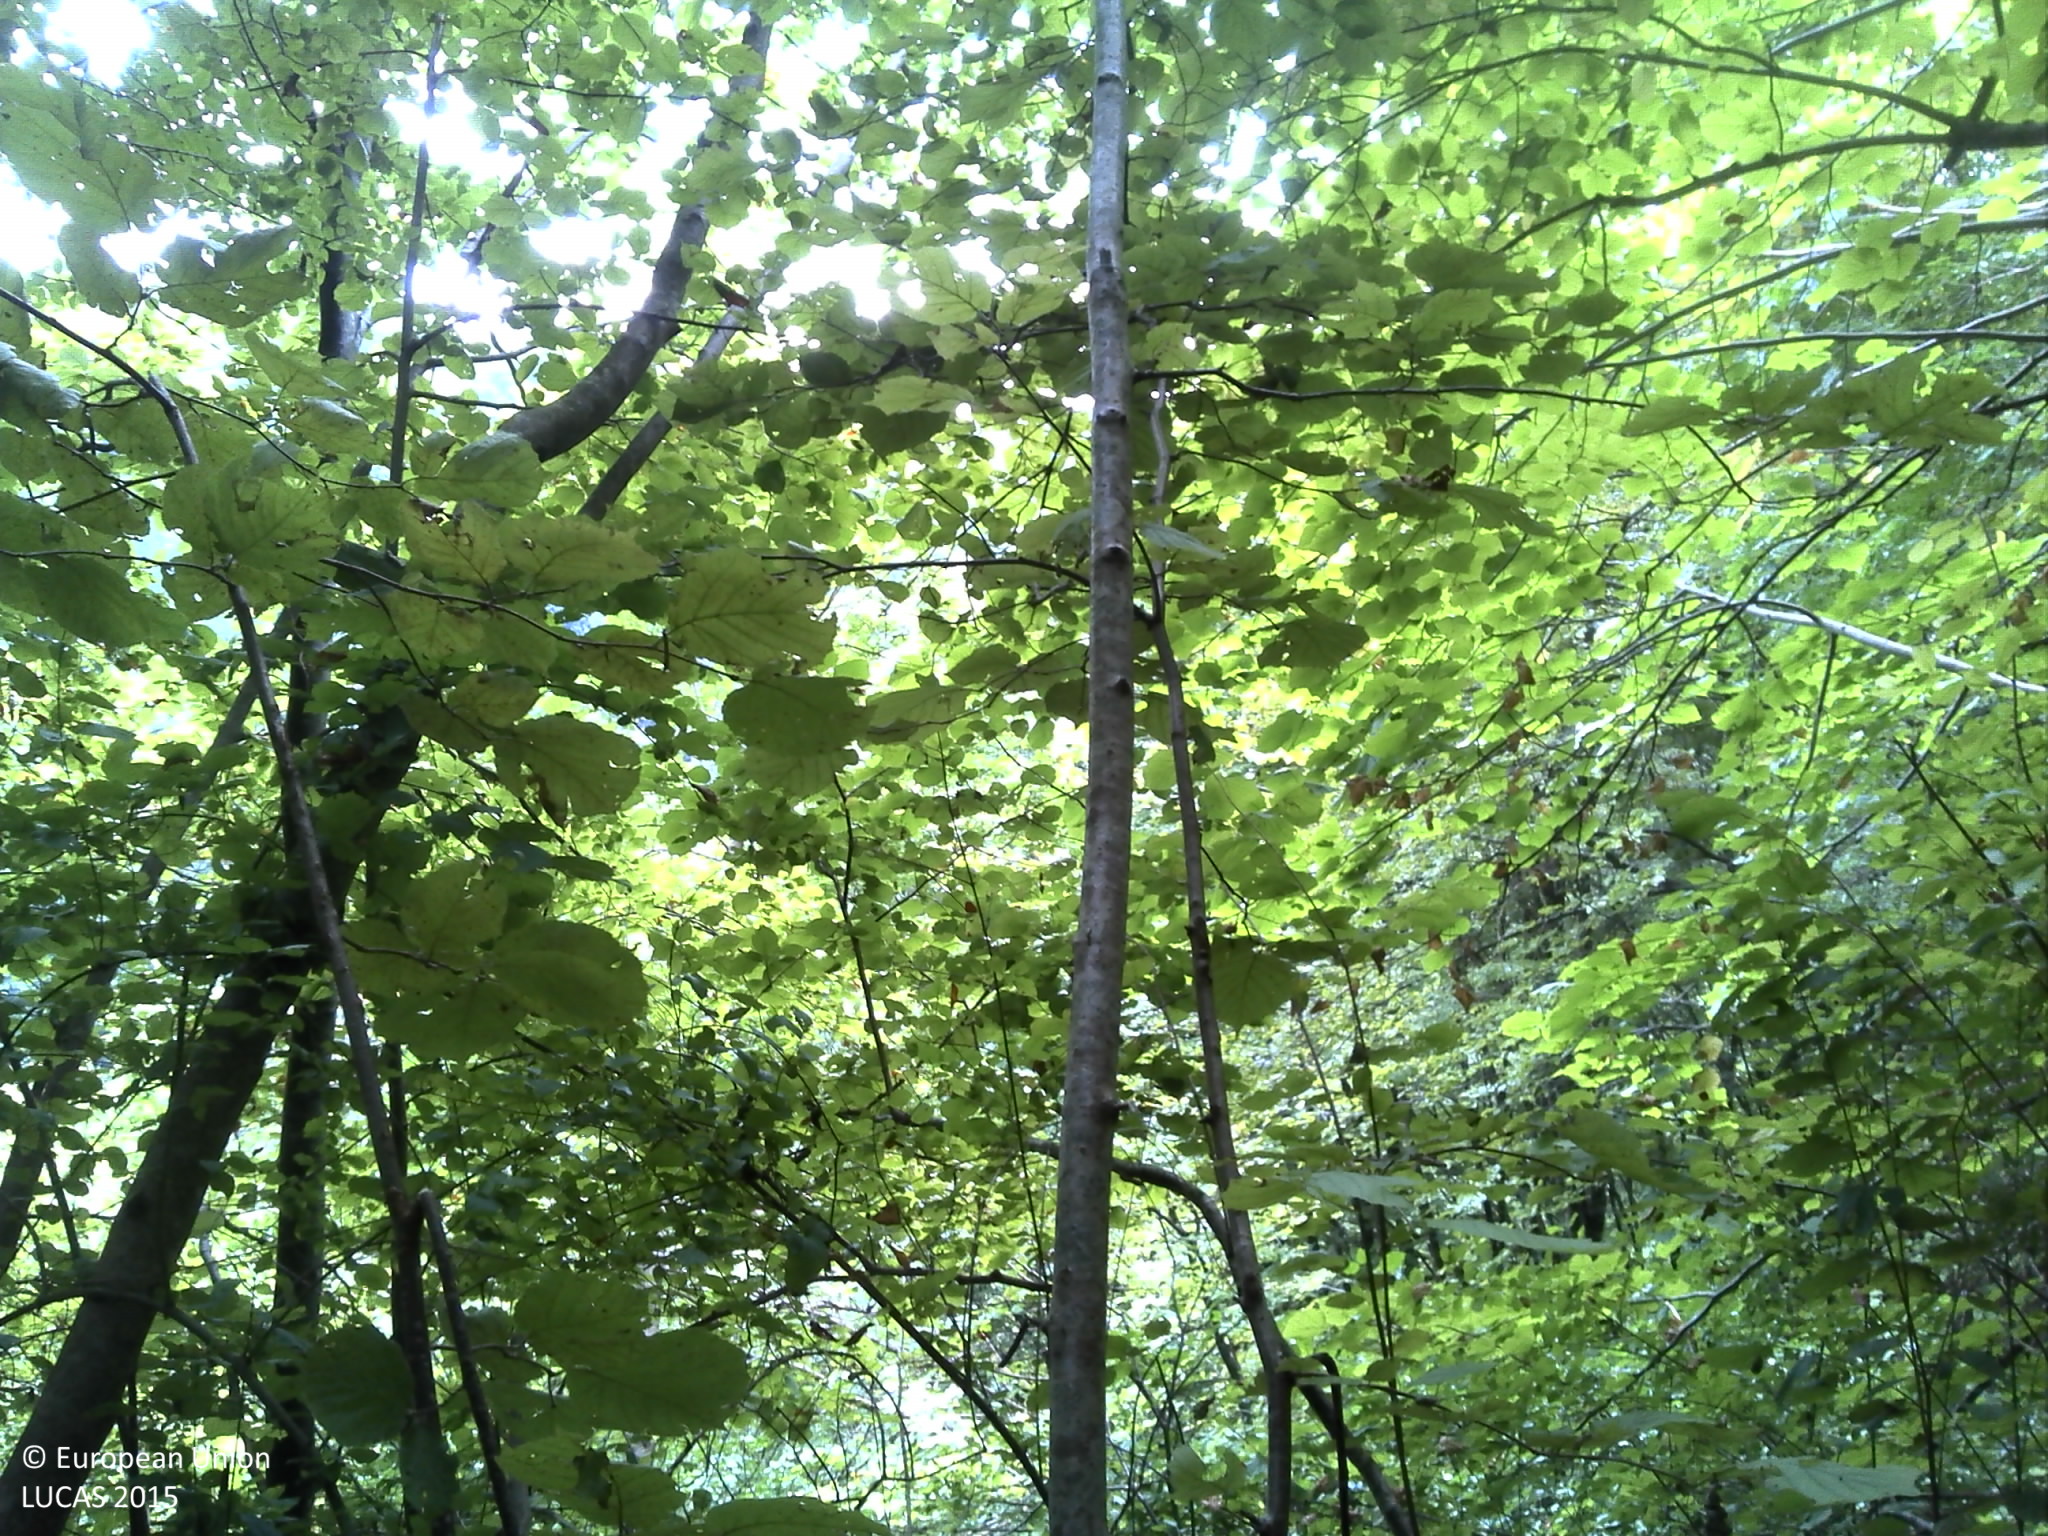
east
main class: Woodland
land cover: Broadleaved woodland
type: beech forest
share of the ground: > 75 %
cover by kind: broadleaved forest trees 100 %
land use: Forestry
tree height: > 5 m
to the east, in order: Broadleaved woodland; Tracks; Shrubland with sparse tree cover; Broadleaved woodland; Rivers and streams; Broadleaved woodland; Shrubland with sparse tree cover; Broadleaved woodland
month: September
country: HR
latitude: 45.2107
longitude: 15.6106
